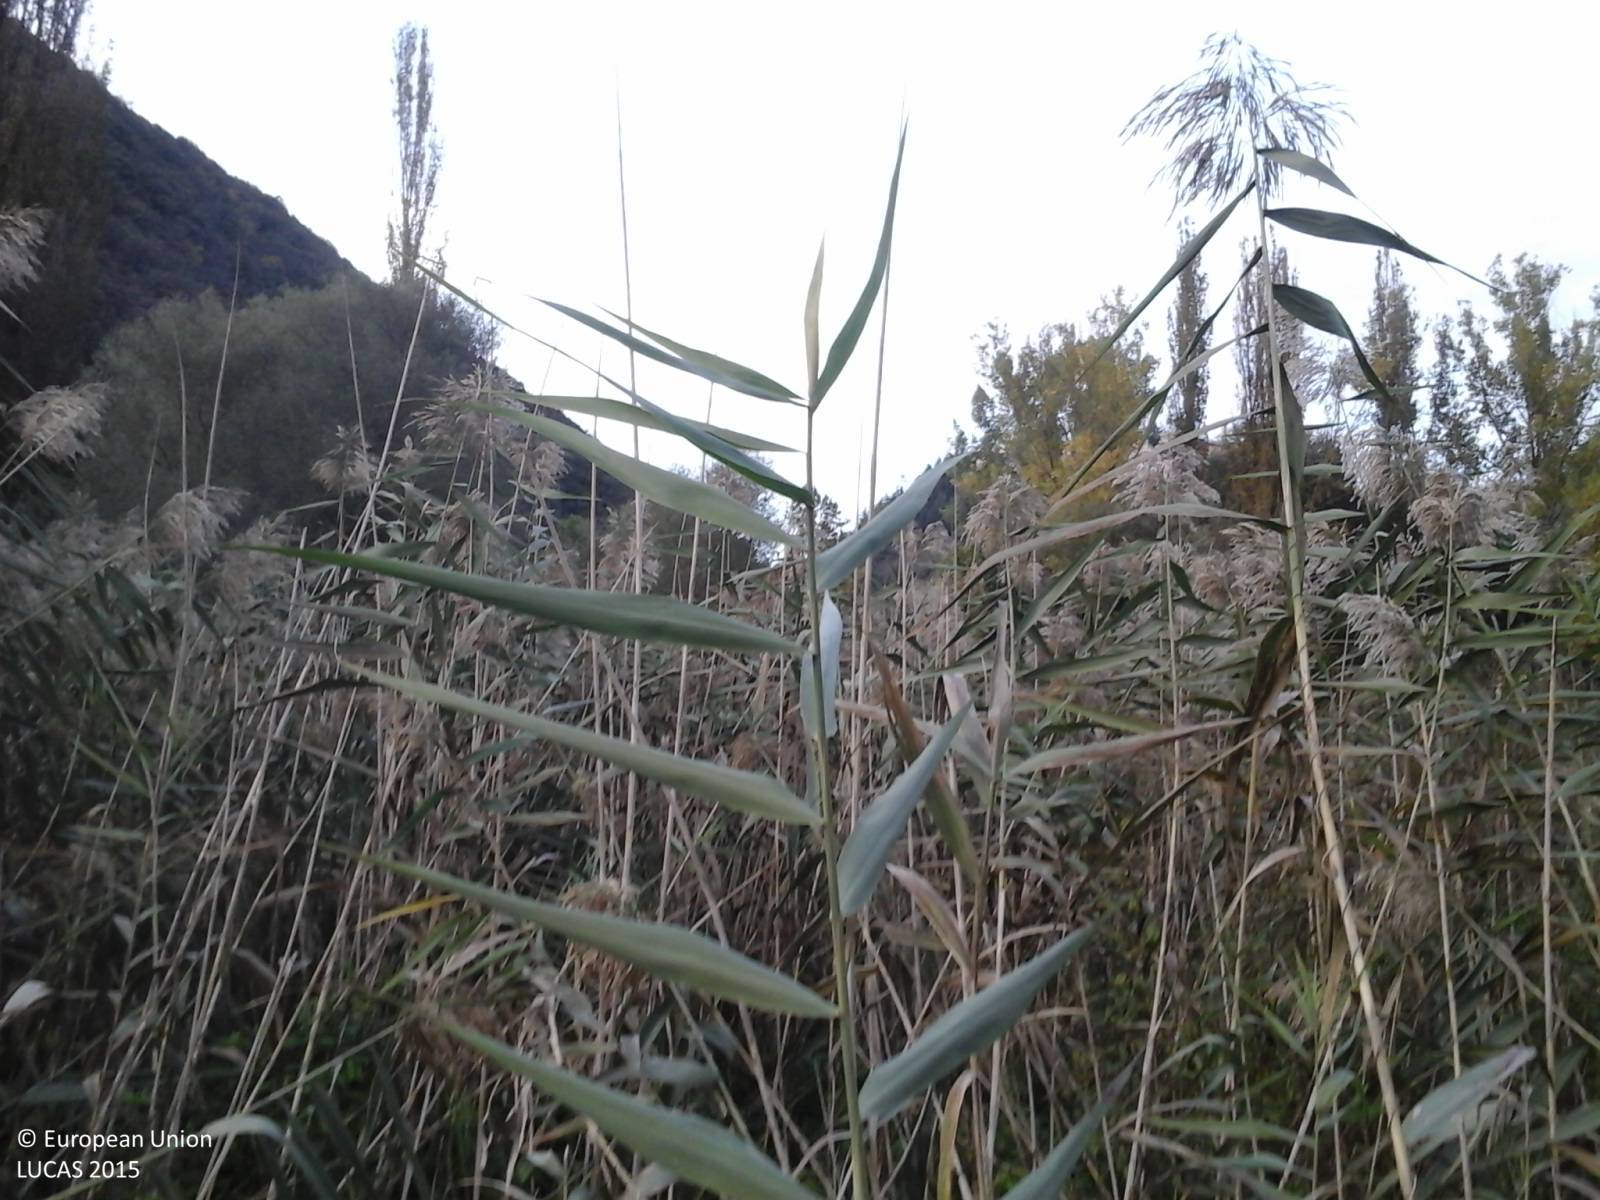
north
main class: Shrubland
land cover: Shrubland with sparse tree cover
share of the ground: 50 - 75 %
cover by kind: shrubs 70 %, herbaceous plants 25 %, broadleaved forest trees 5 %
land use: Abandoned areas
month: October
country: IT
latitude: 42.8109
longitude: 12.9140
